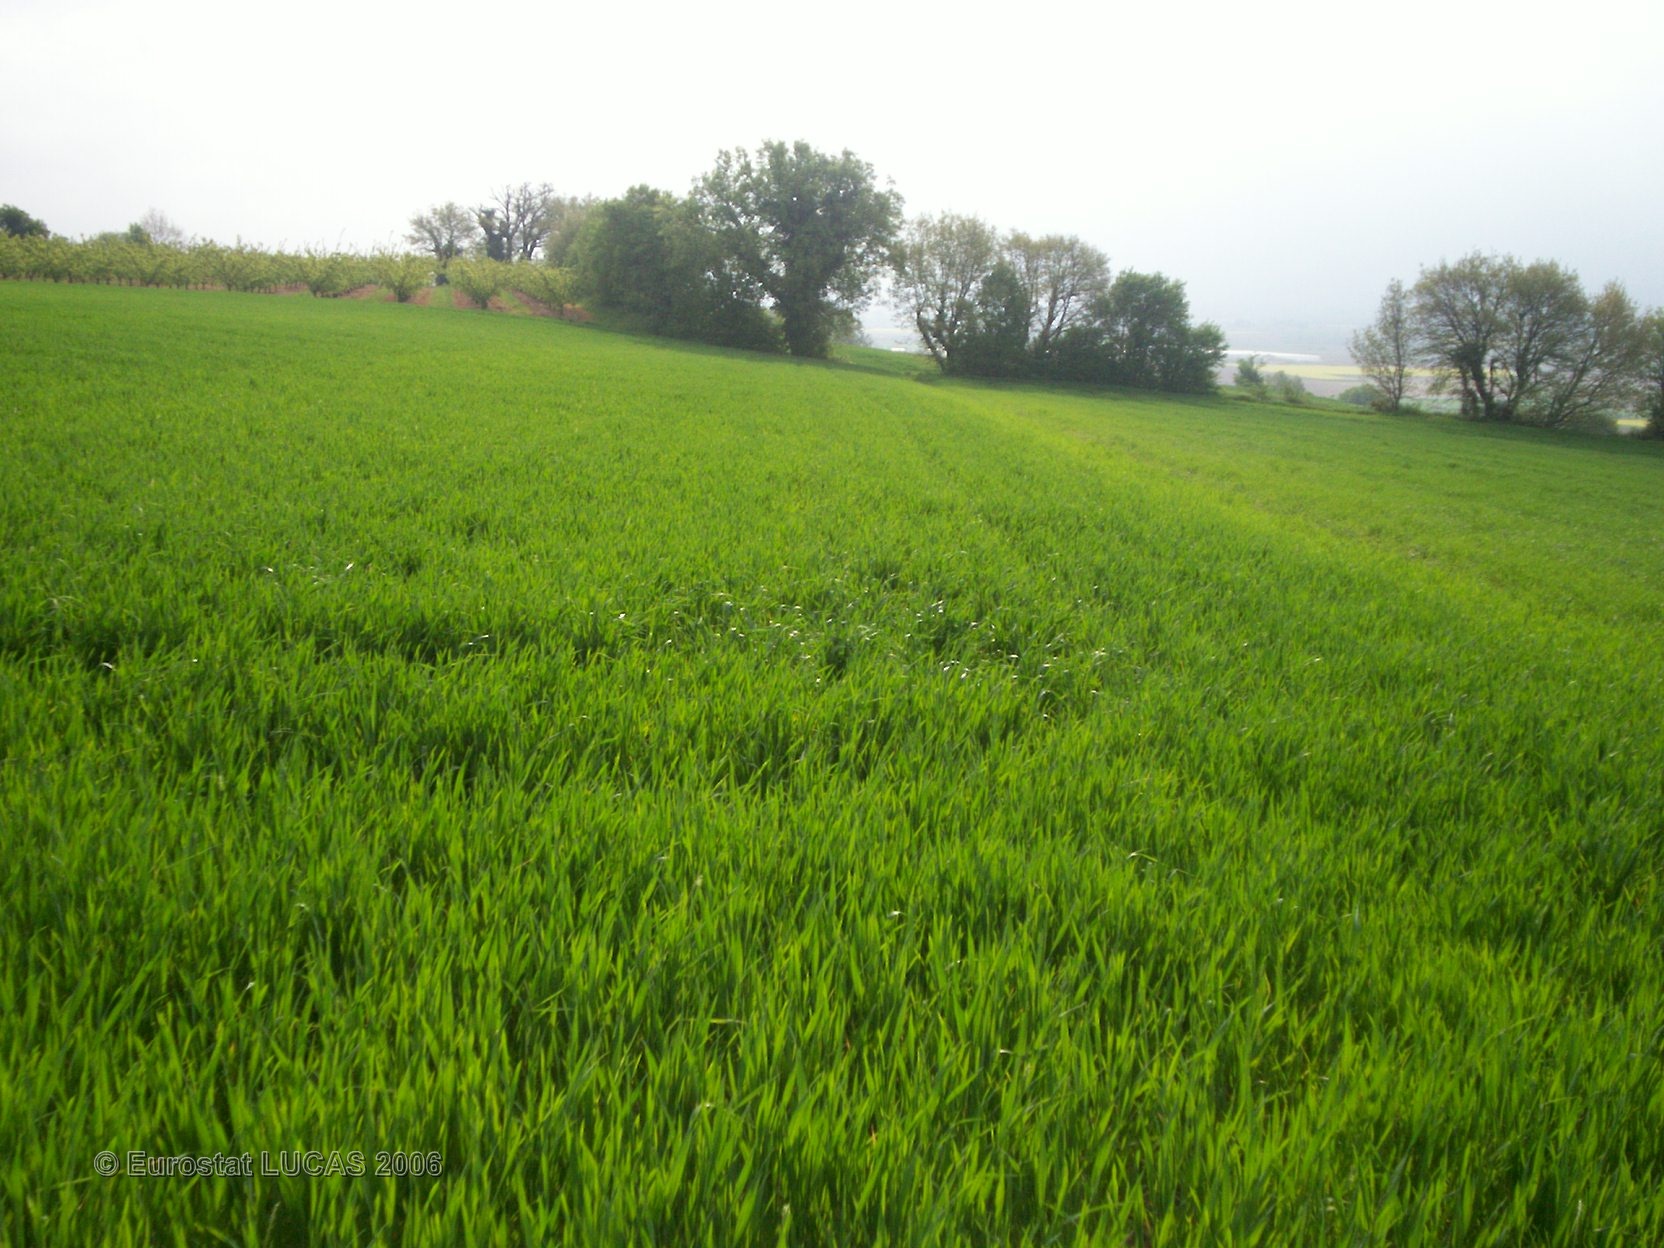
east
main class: Cropland
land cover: Common wheat
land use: Agriculture (excluding fallow land and kitchen gardens)
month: April
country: FR
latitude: 45.3432
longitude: 4.8614
